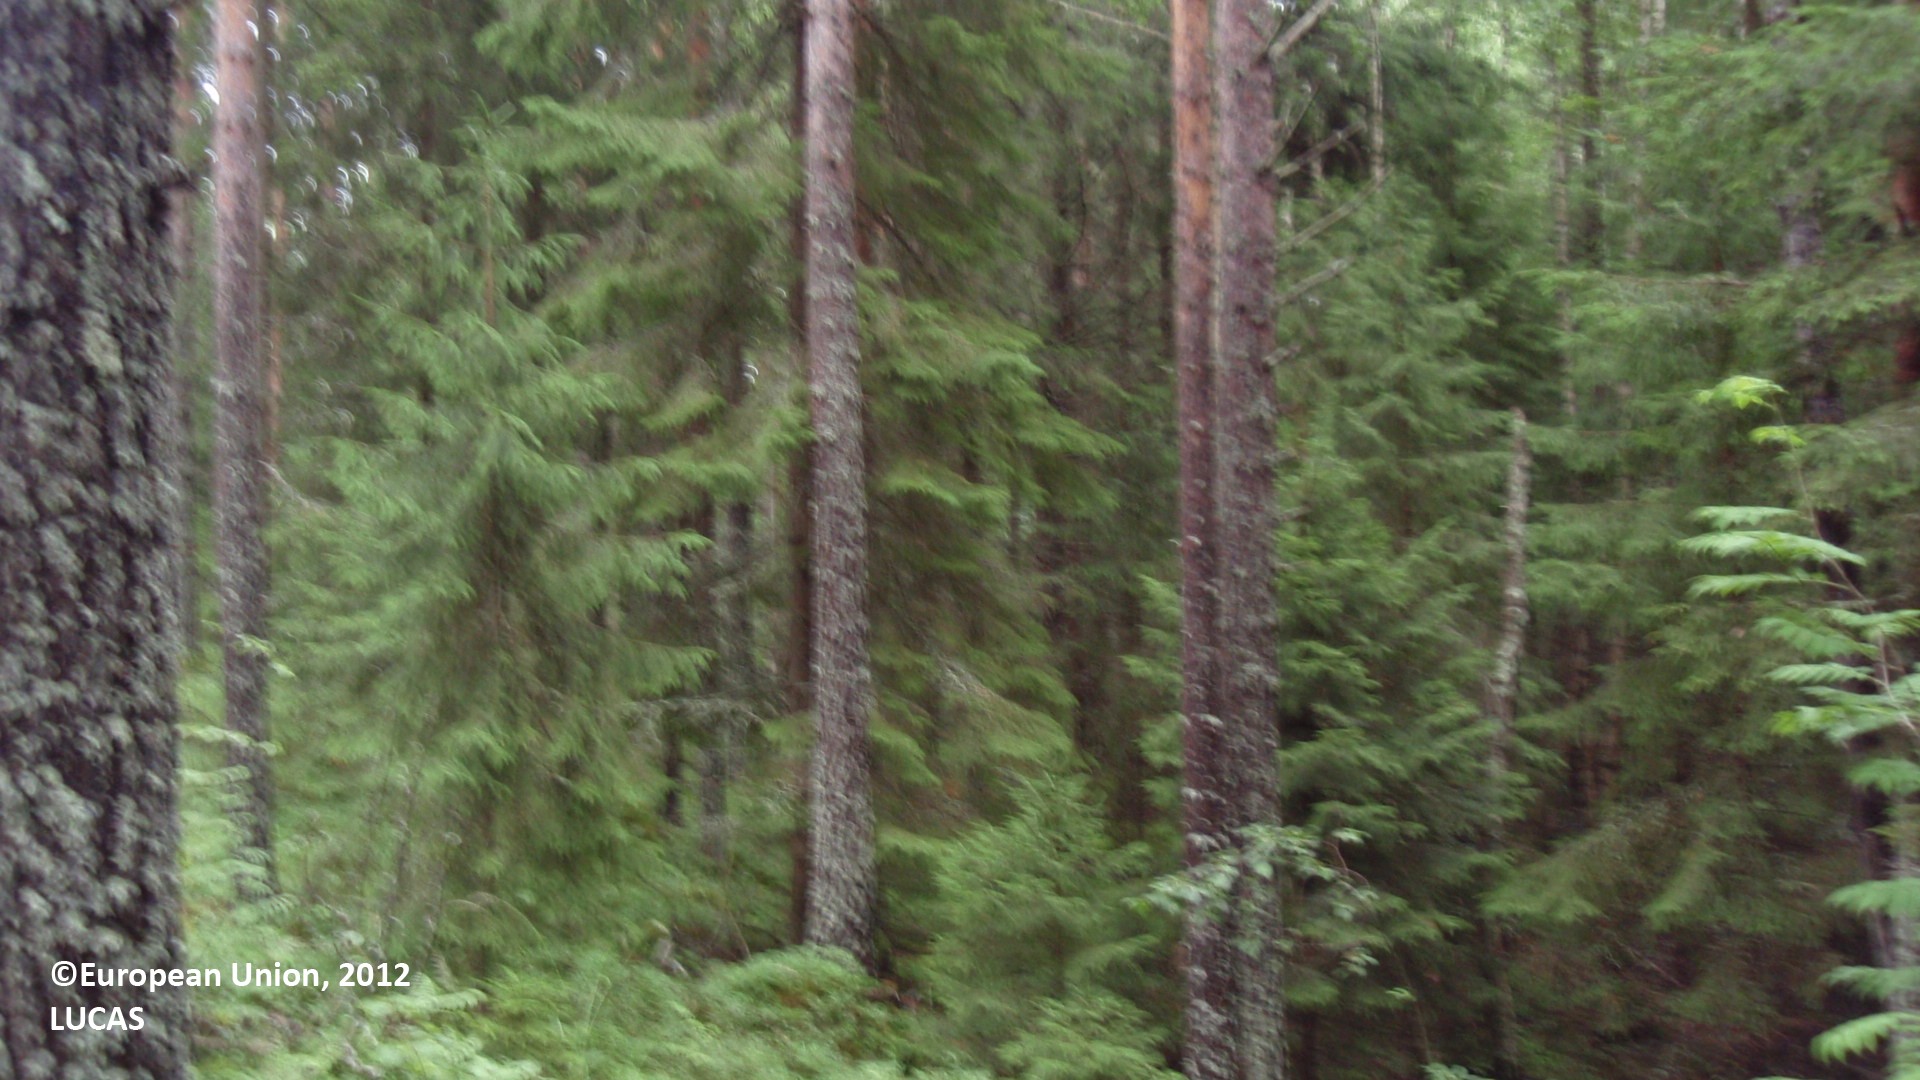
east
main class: Woodland
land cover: Pine dominated coniferous woodland
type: boreal forest
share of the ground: 25 - 50 %
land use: Forestry
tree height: > 5 m
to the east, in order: Pine dominated coniferous woodland; Spruce dominated coniferous woodland; Pine dominated mixed woodland; Artificial constructions in urban areas; Inland water bodies
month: July
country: FI
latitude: 61.5199
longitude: 27.3354
